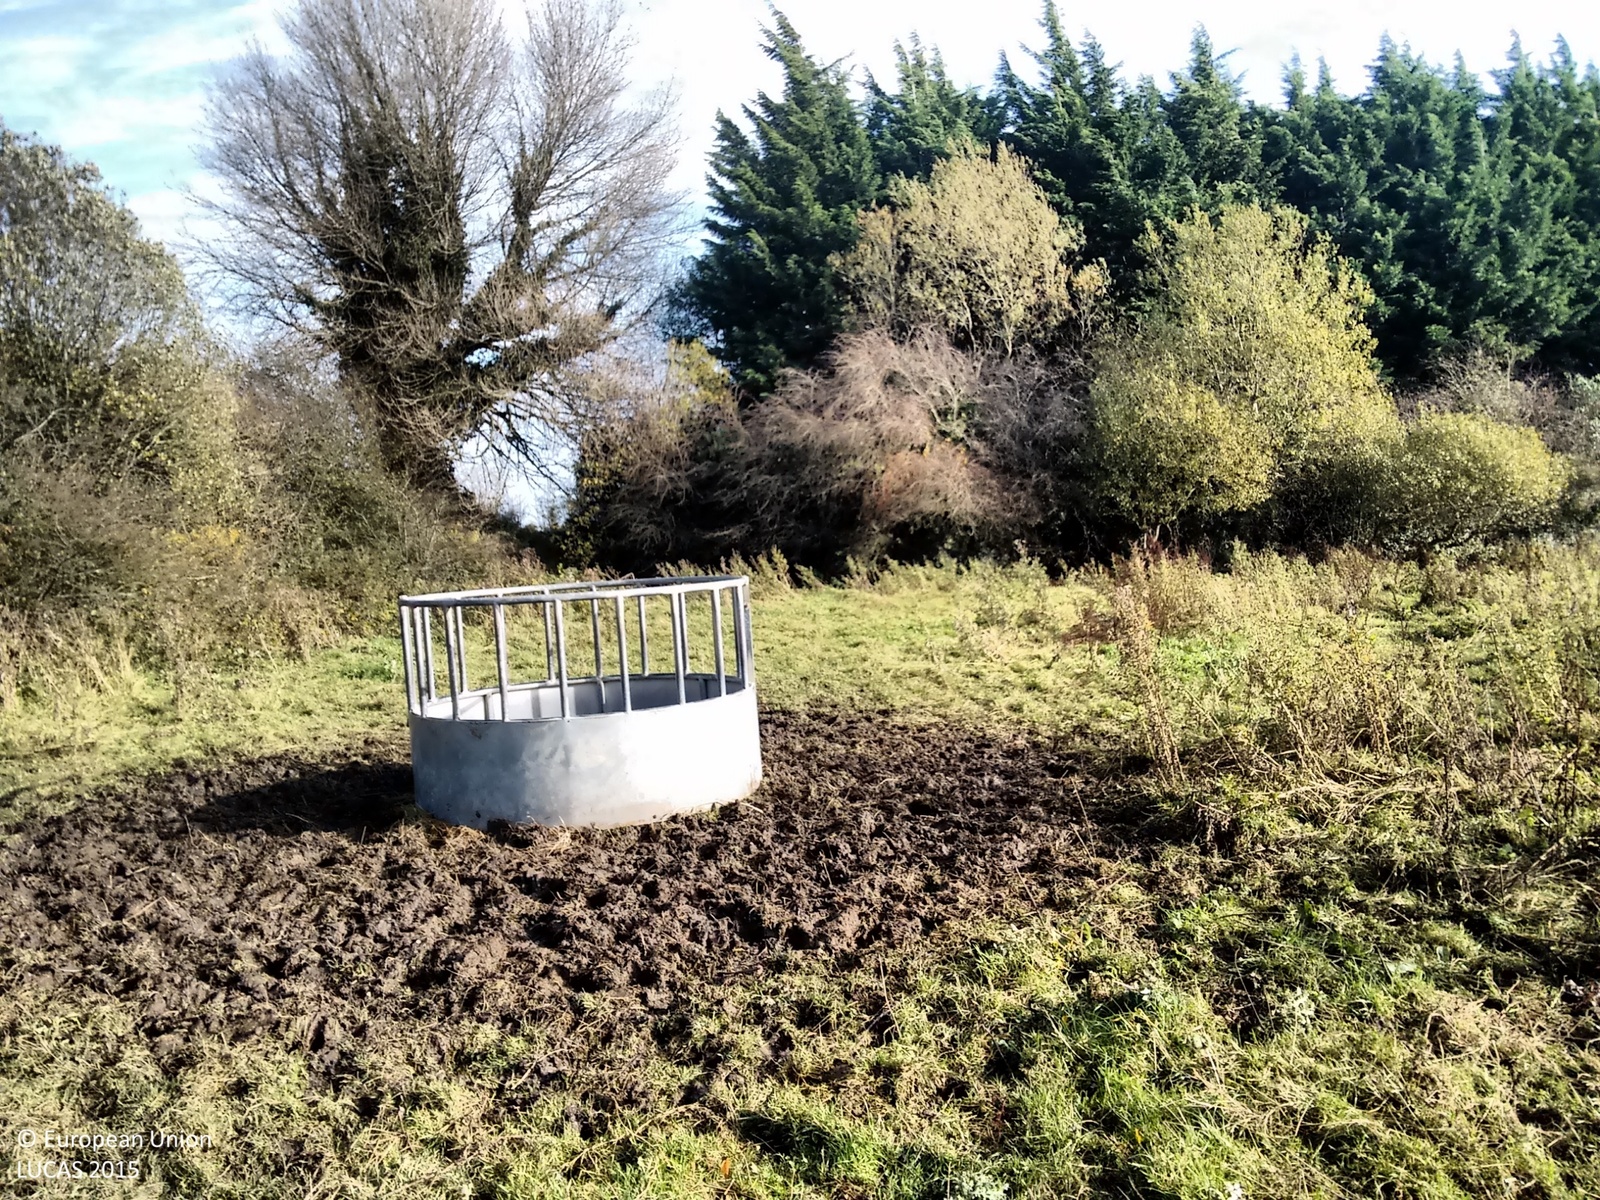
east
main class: Grassland
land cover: Grassland without tree/shrub cover
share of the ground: > 75 %
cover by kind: herbaceous plants 95 %, shrubs 5 %
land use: Agriculture (excluding fallow land and kitchen gardens)
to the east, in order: Grassland without tree/shrub cover; Other mixed woodland; Artificial constructions in urban areas; Grassland without tree/shrub cover; Artificial constructions in urban areas; Broadleaved woodland; Grassland without tree/shrub cover
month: October
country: IE
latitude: 53.2247
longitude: -7.8292
